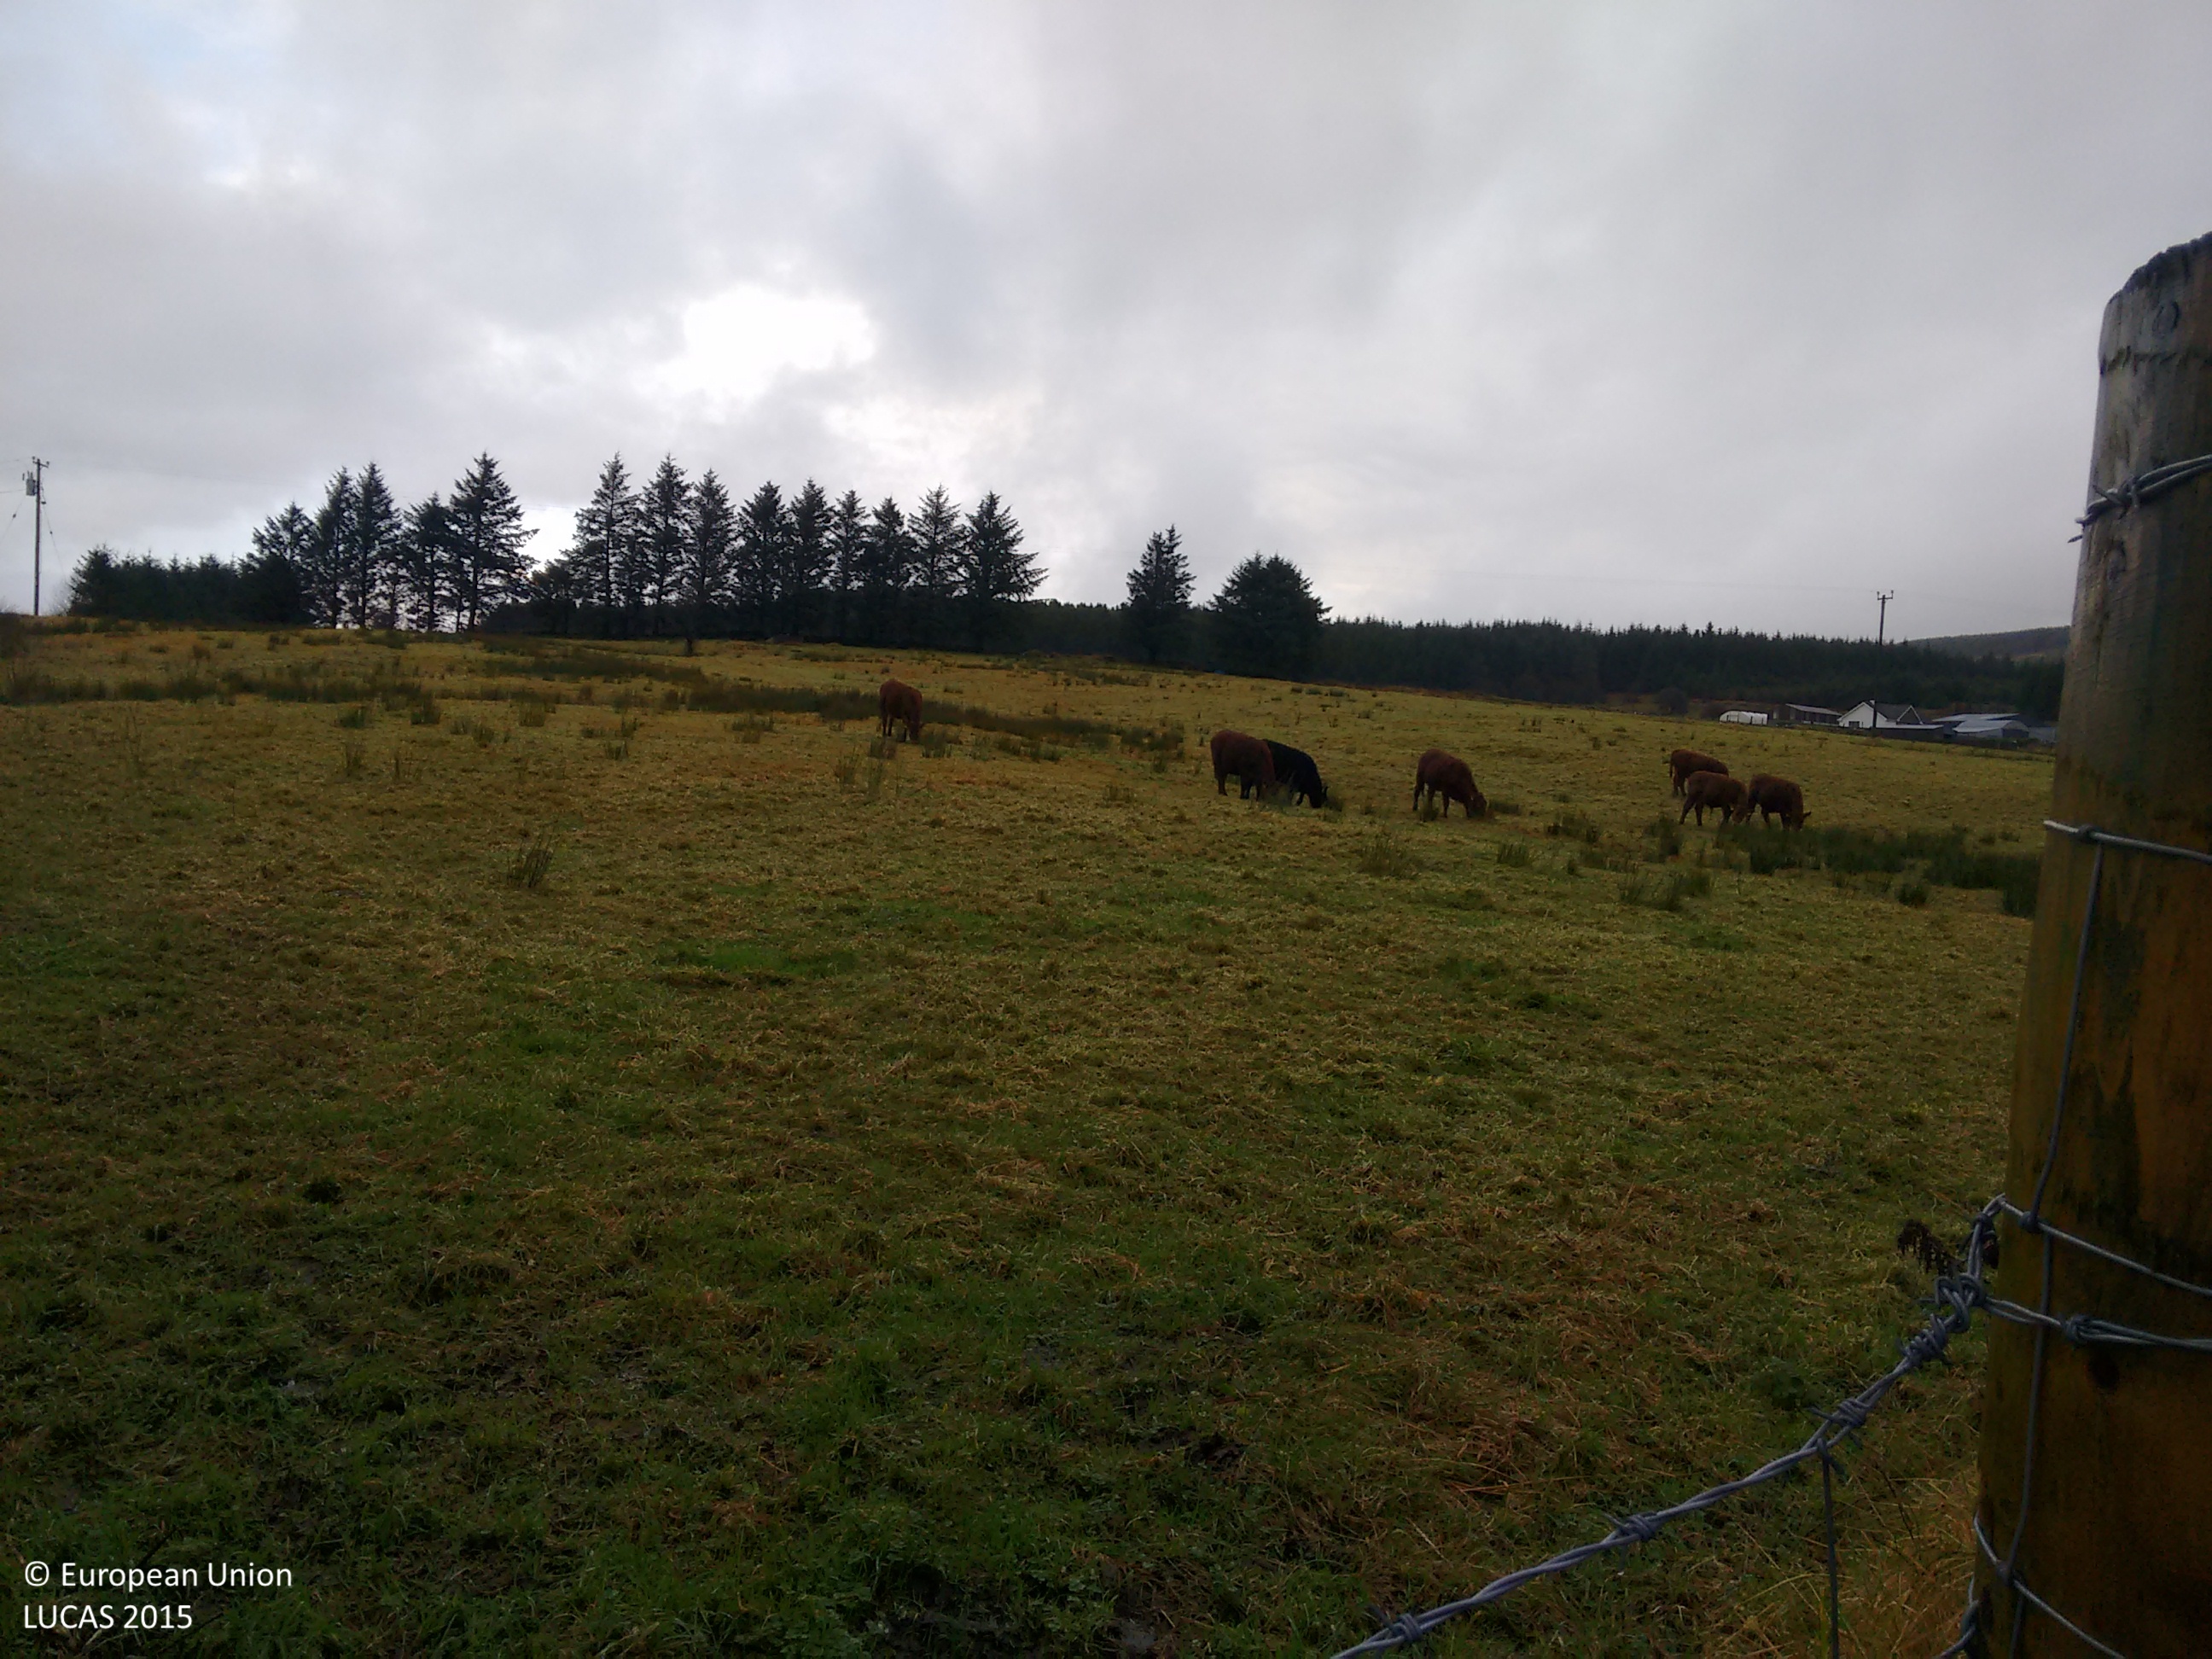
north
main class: Grassland
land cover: Grassland without tree/shrub cover
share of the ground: > 75 %
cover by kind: herbaceous plants 100 %
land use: Agriculture (excluding fallow land and kitchen gardens)
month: November
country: IE
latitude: 54.1212
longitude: -8.2525
